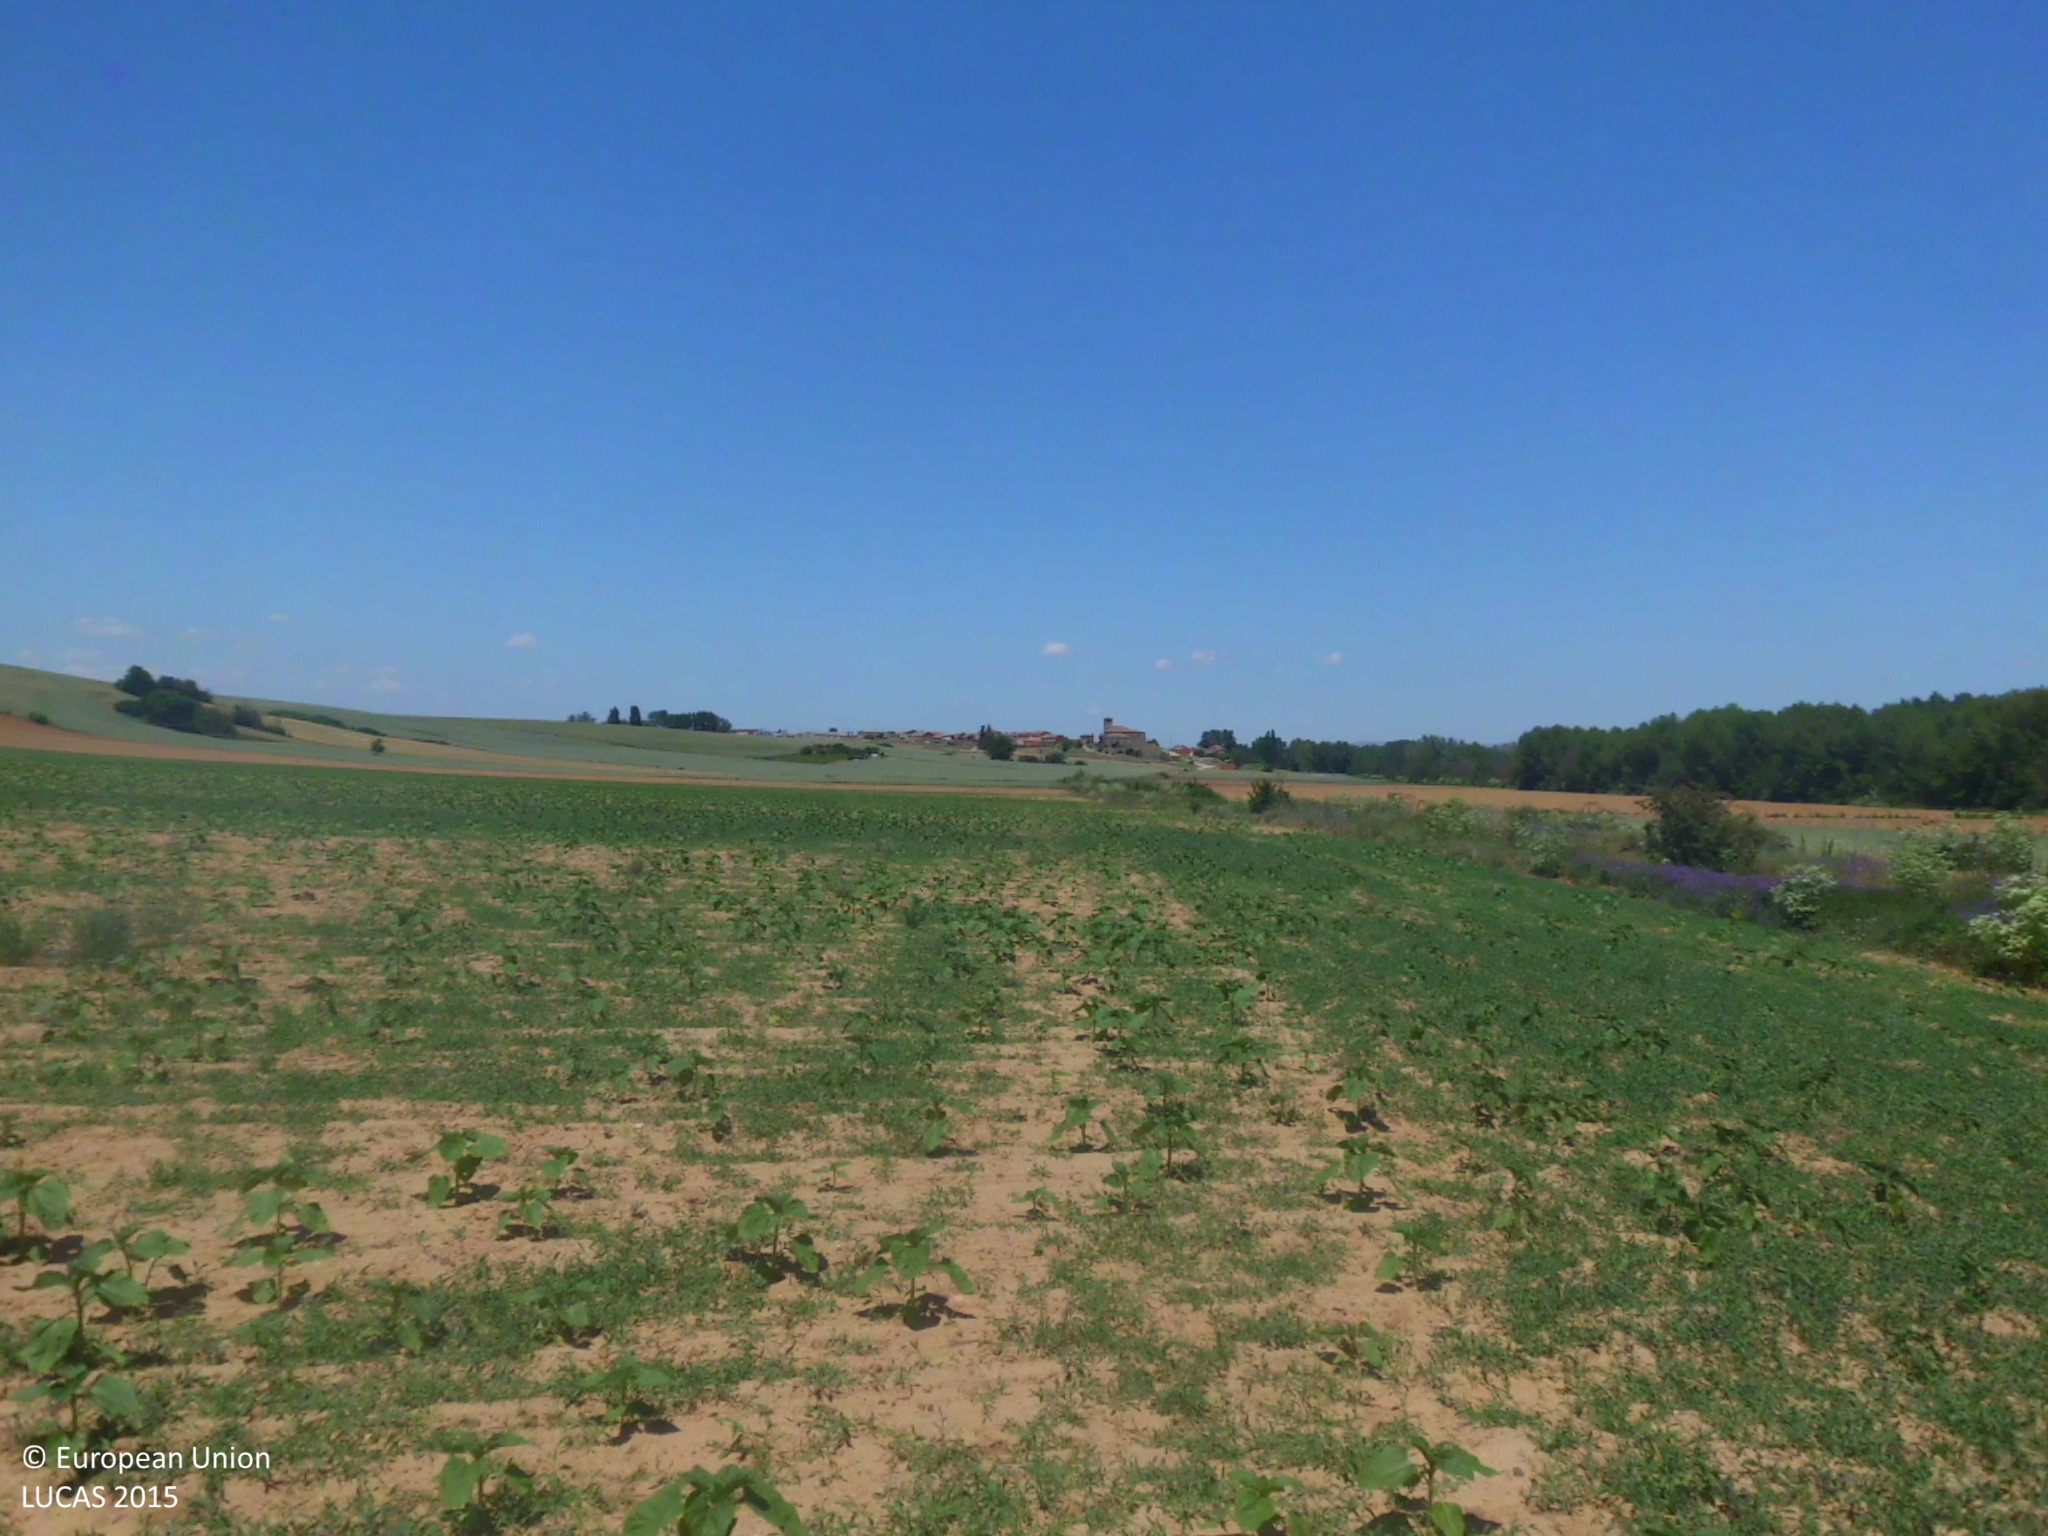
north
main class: Cropland
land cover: Sunflower
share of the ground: < 10 %
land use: Agriculture (excluding fallow land and kitchen gardens)
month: June
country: ES
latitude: 42.4626
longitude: -4.2631
